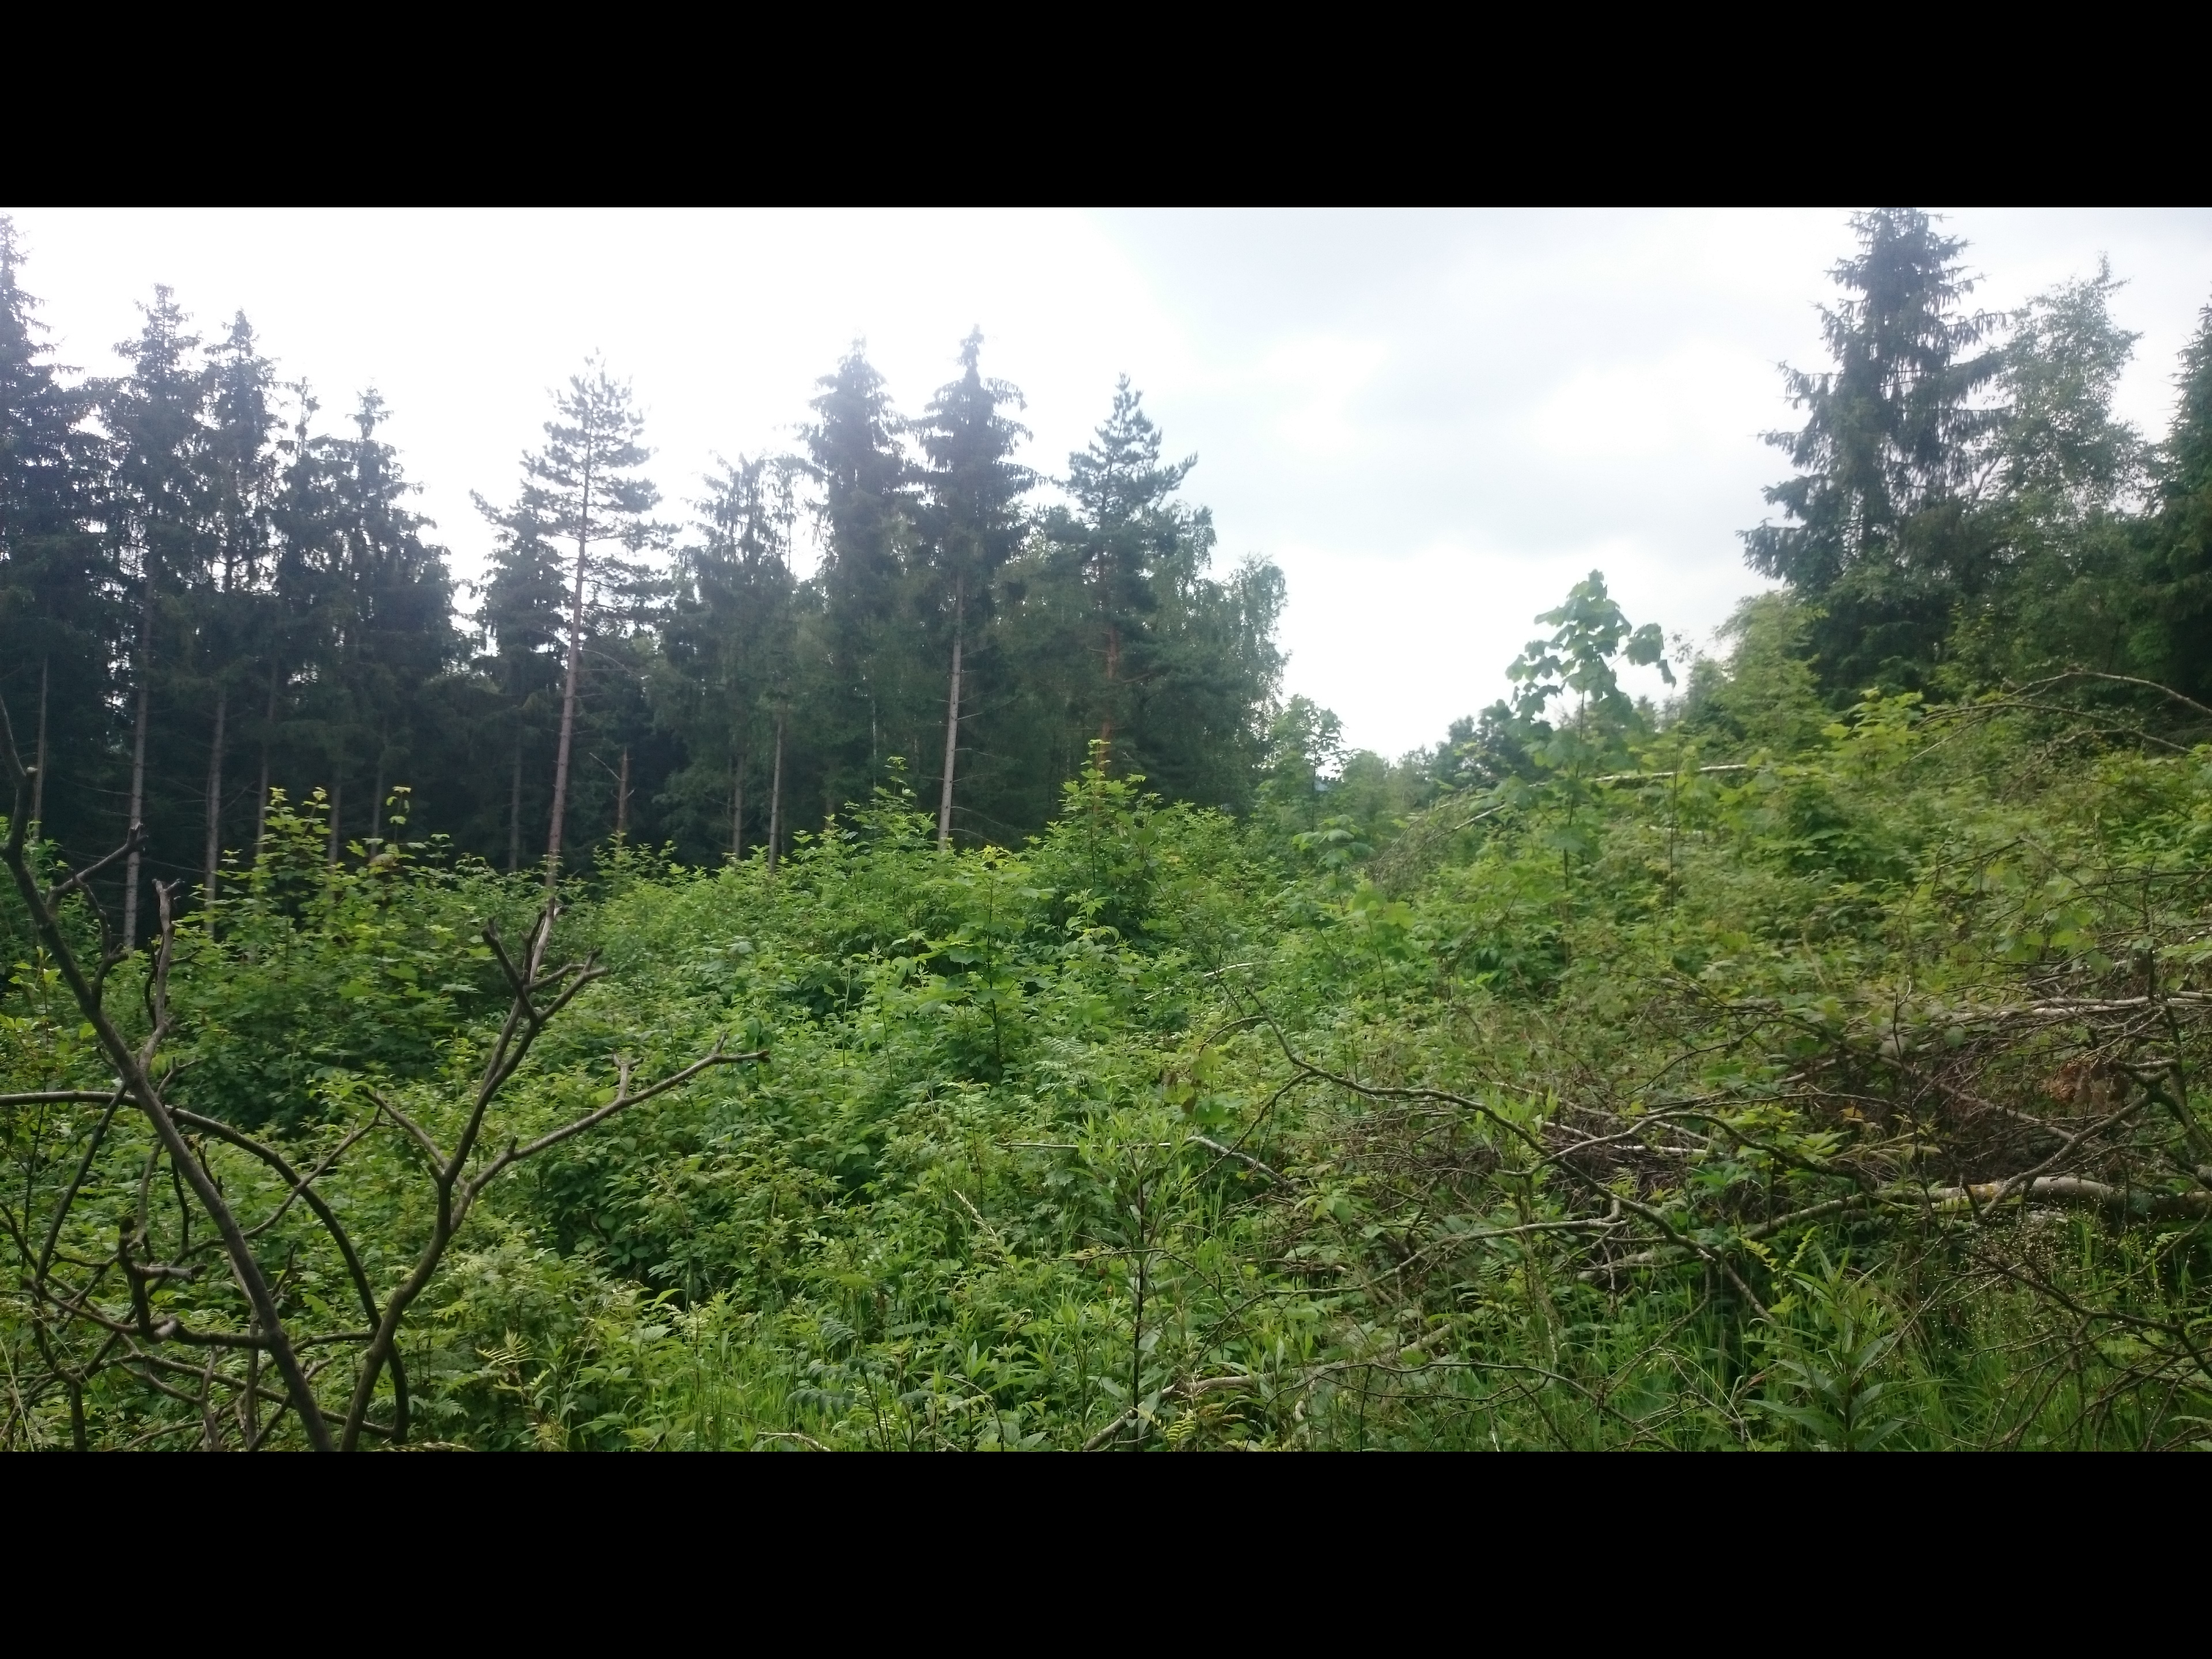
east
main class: Woodland
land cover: Broadleaved woodland
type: non-riverine alder, birch or aspen forest
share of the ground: 25 - 50 %
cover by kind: broadleaved forest trees 40 %, herbaceous plants 30 %, shrubs 25 %, coniferous forest trees 5 %
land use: Forestry
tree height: > 5 m
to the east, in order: Broadleaved woodland; Shrubland with sparse tree cover; Tracks; Spruce dominated coniferous woodland; Tracks; Grassland without tree/shrub cover; Fences; Grassland without tree/shrub cover; Single bushes/trees; Grassland without tree/shrub cover; Fences; Grassland without tree/shrub cover; Fences; Grassland without tree/shrub cover
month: June
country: AT
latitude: 48.6230
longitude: 14.8175
